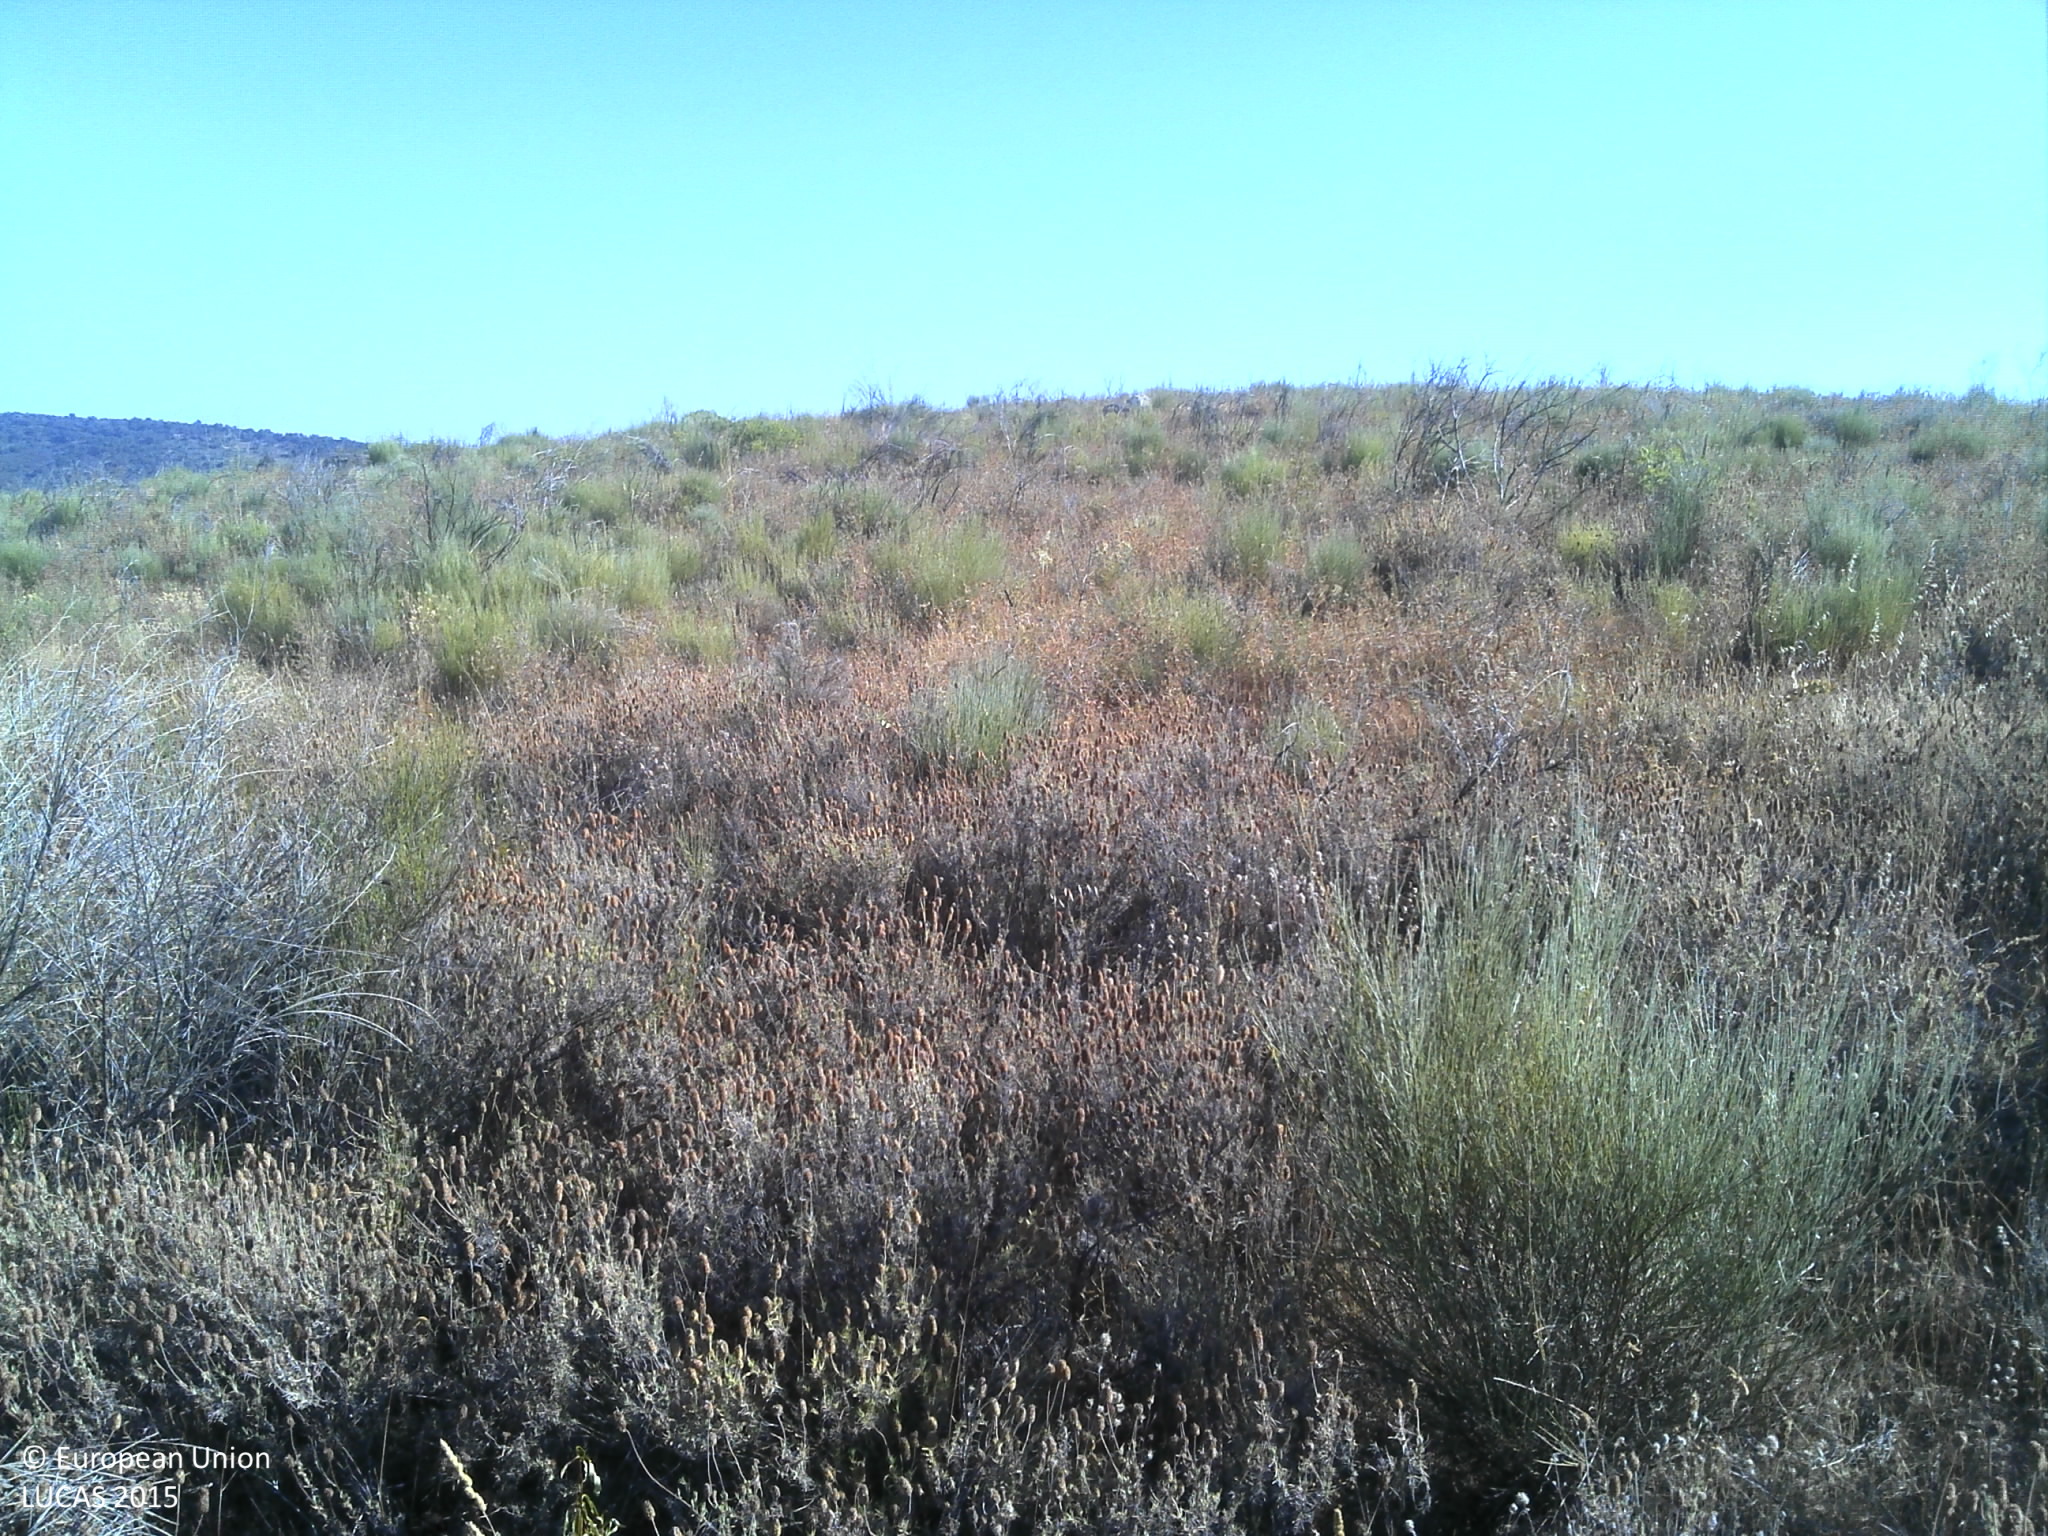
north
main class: Shrubland
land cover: Shrubland without tree cover
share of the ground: > 75 %
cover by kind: shrubs 100 %
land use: Semi-natural and natural areas not in use
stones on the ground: 25 - 50 %
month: July
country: PT
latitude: 41.0841
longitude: -6.9506
